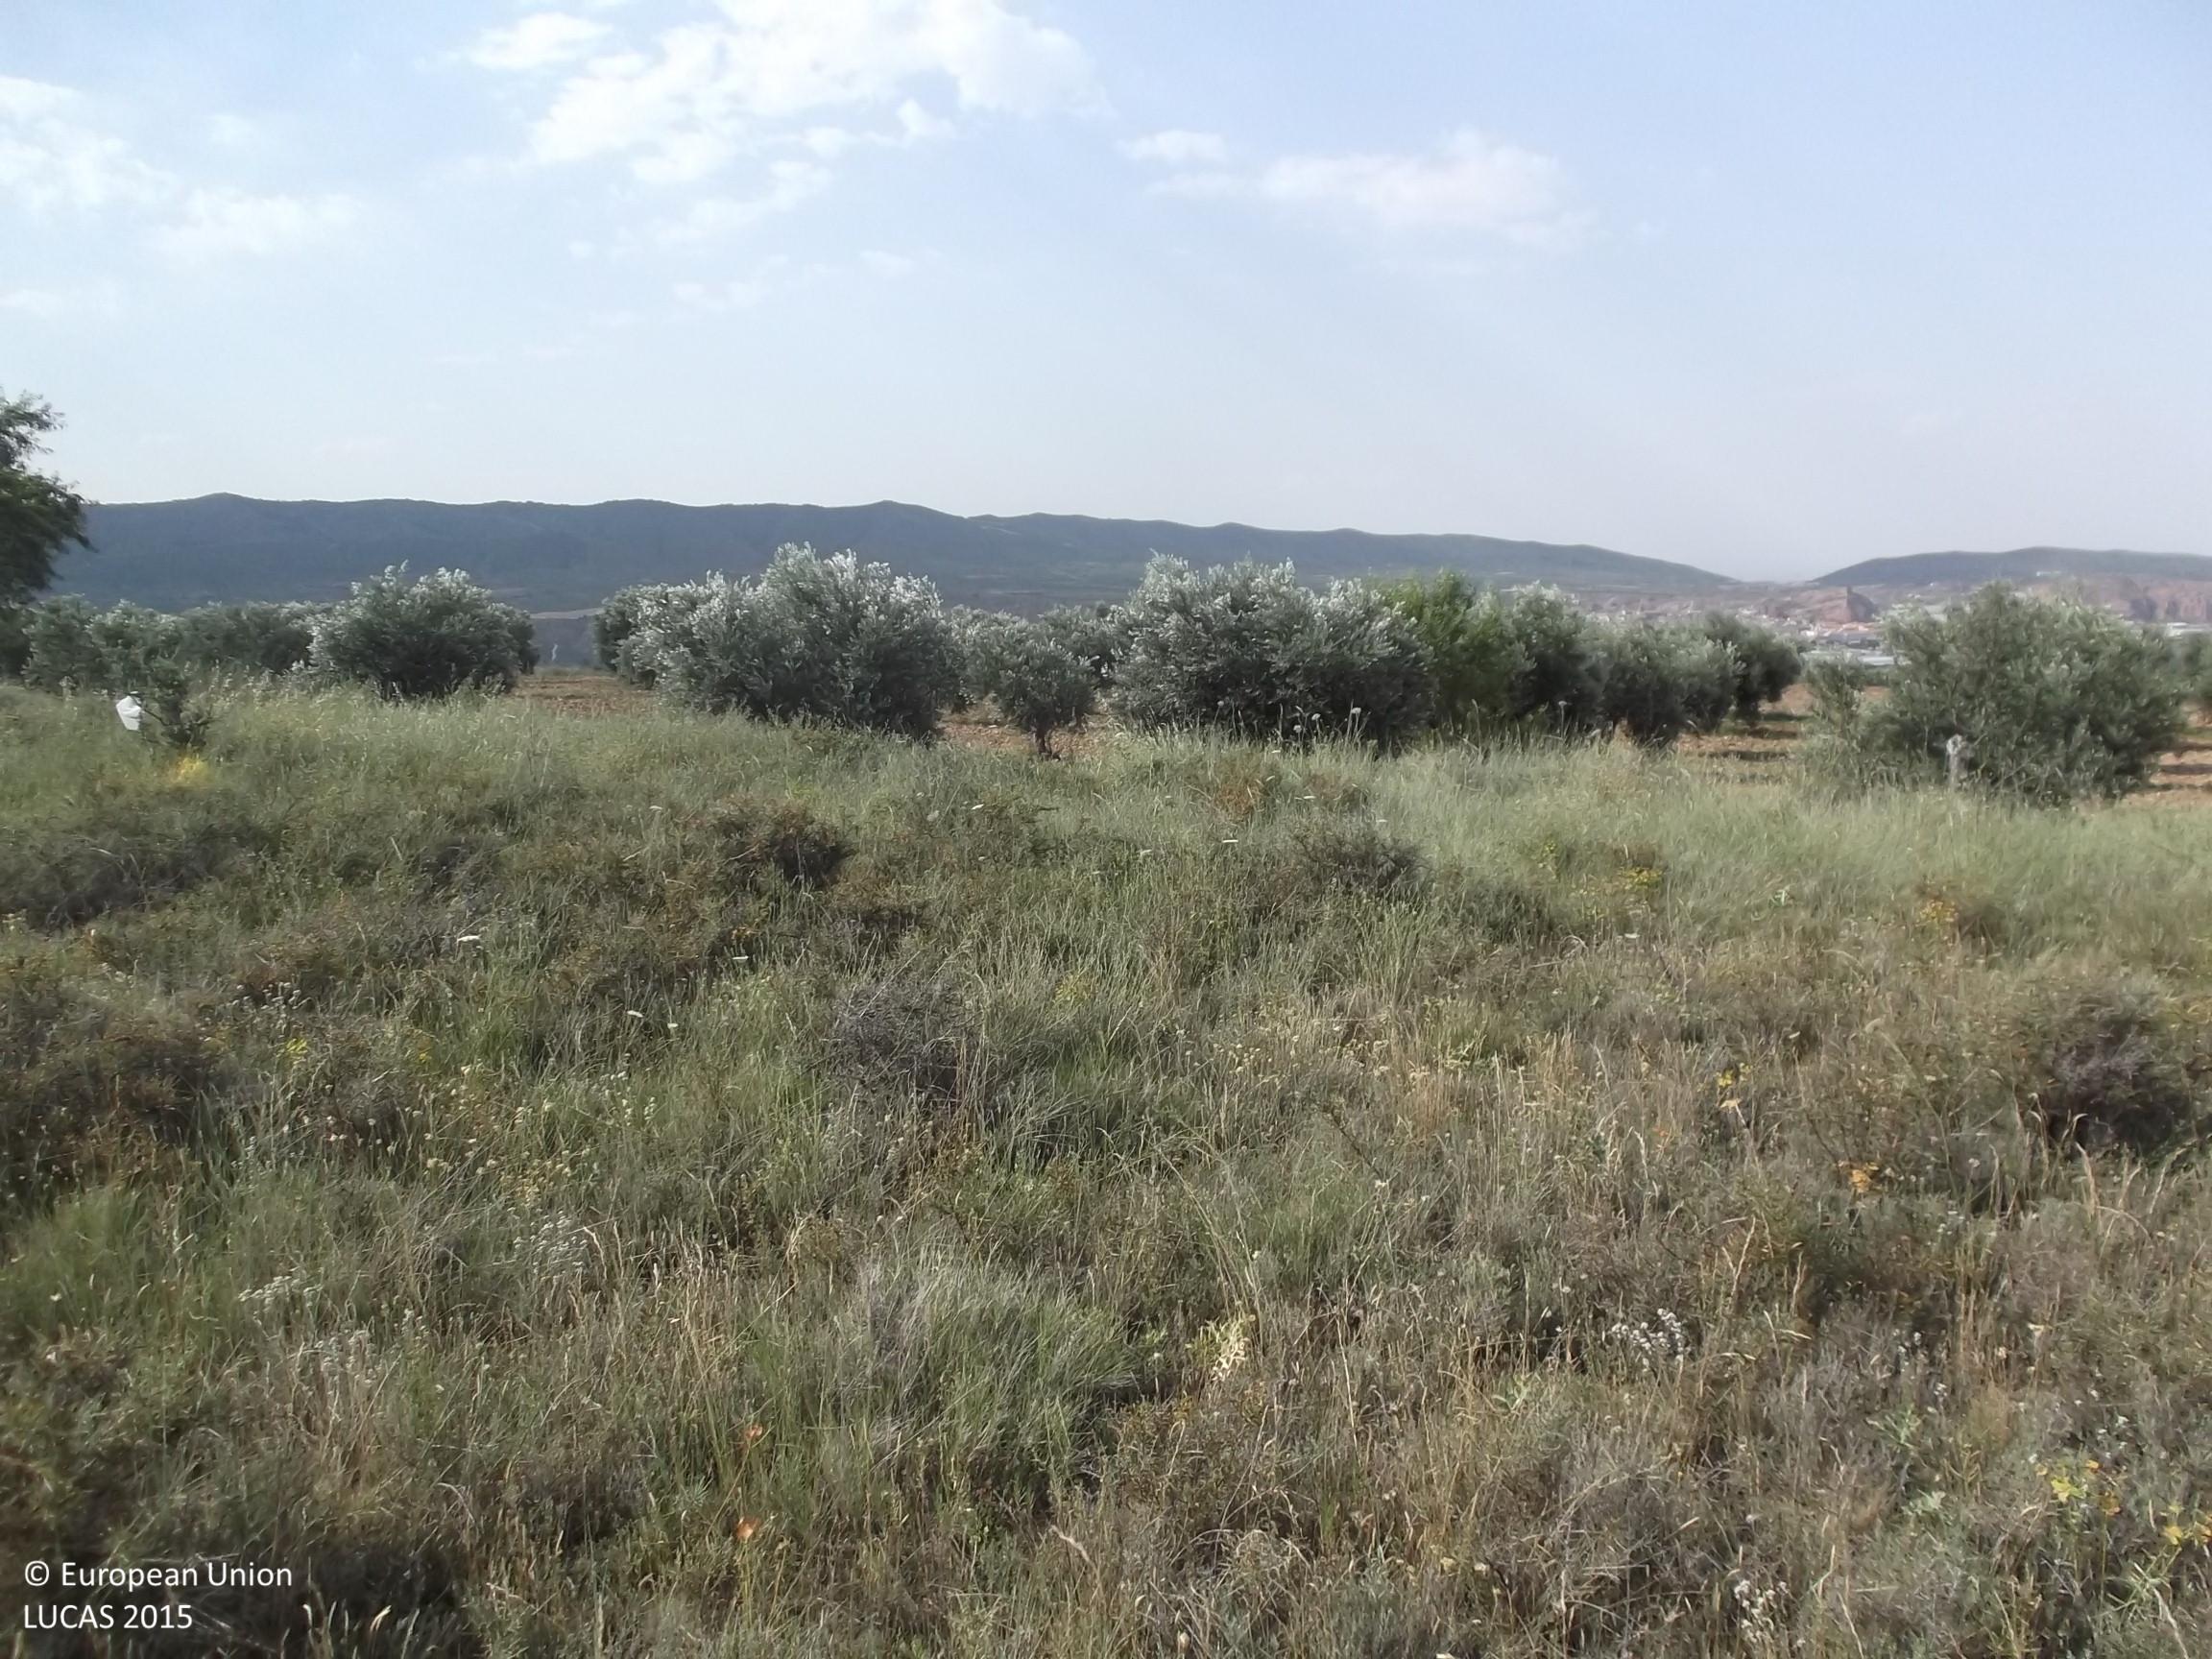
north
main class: Shrubland
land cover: Shrubland without tree cover
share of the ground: > 75 %
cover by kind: shrubs 80 %, herbaceous plants 20 %
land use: Semi-natural and natural areas not in use
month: July
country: ES
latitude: 42.1979
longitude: -2.1124
